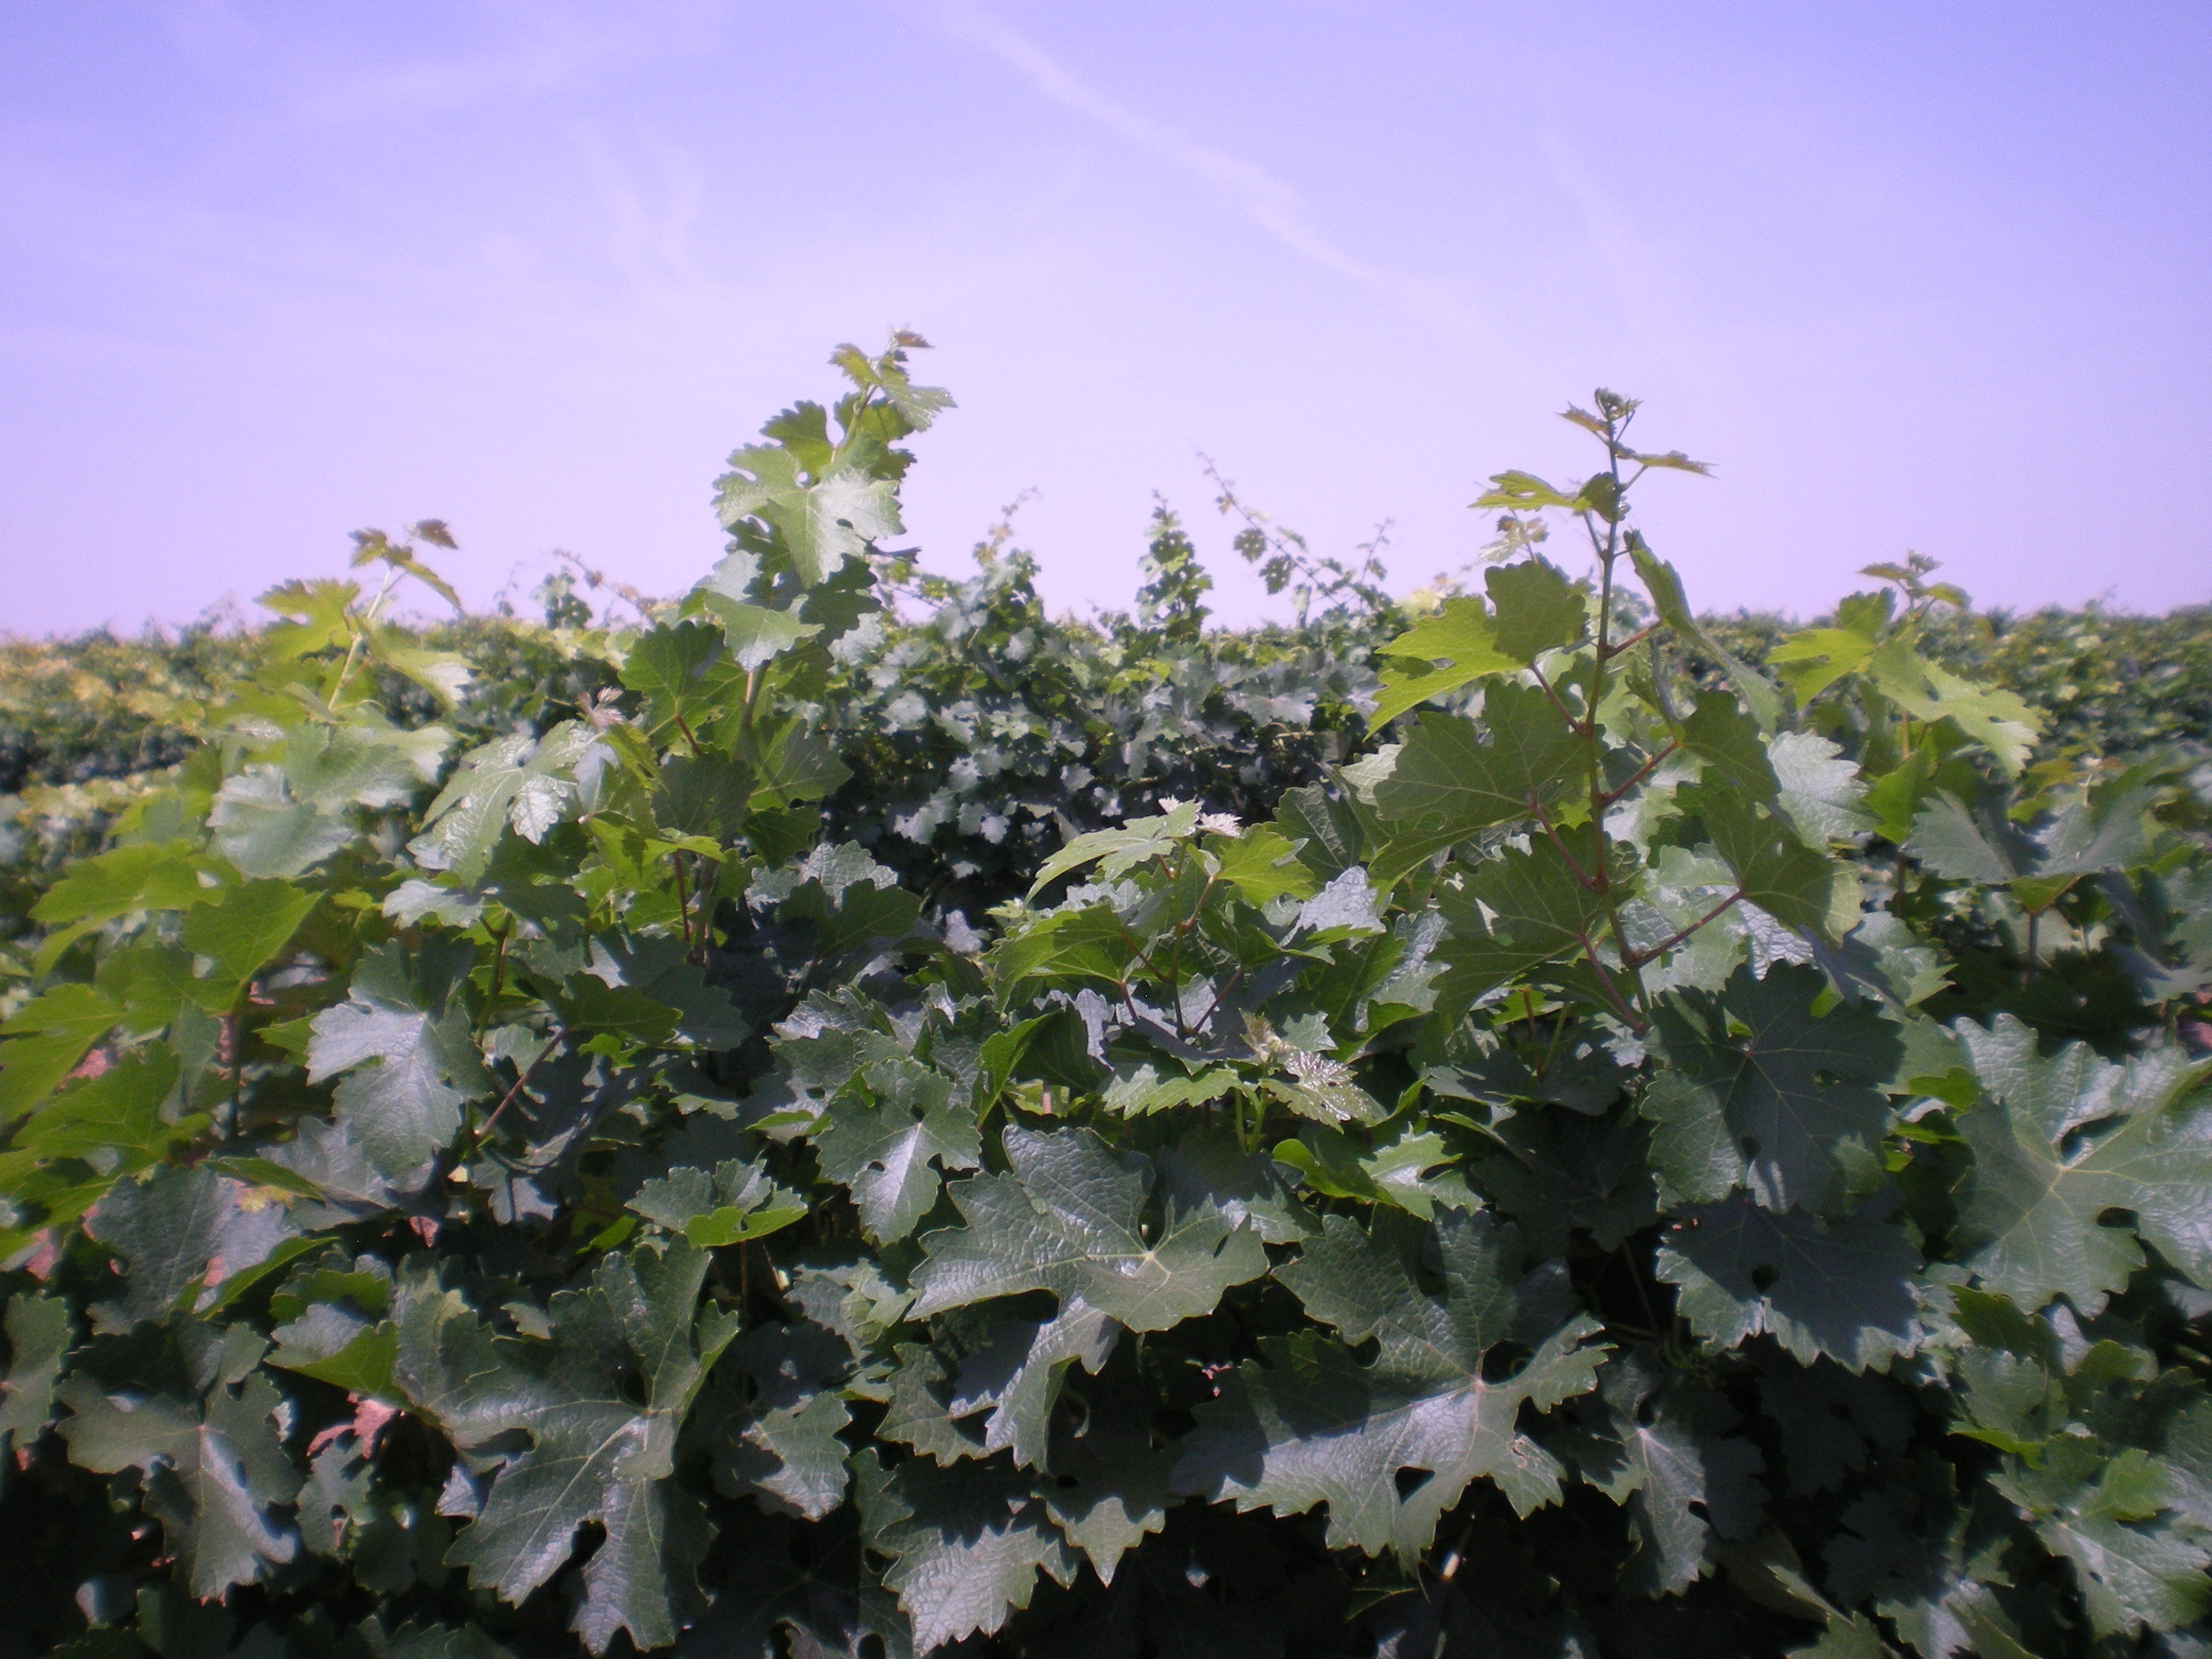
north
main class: Cropland
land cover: Vineyards
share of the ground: 10 - 25 %
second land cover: Other bare soil
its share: > 75 %
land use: Agriculture (excluding fallow land and kitchen gardens)
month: July
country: ES
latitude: 39.2506
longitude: -3.1441
